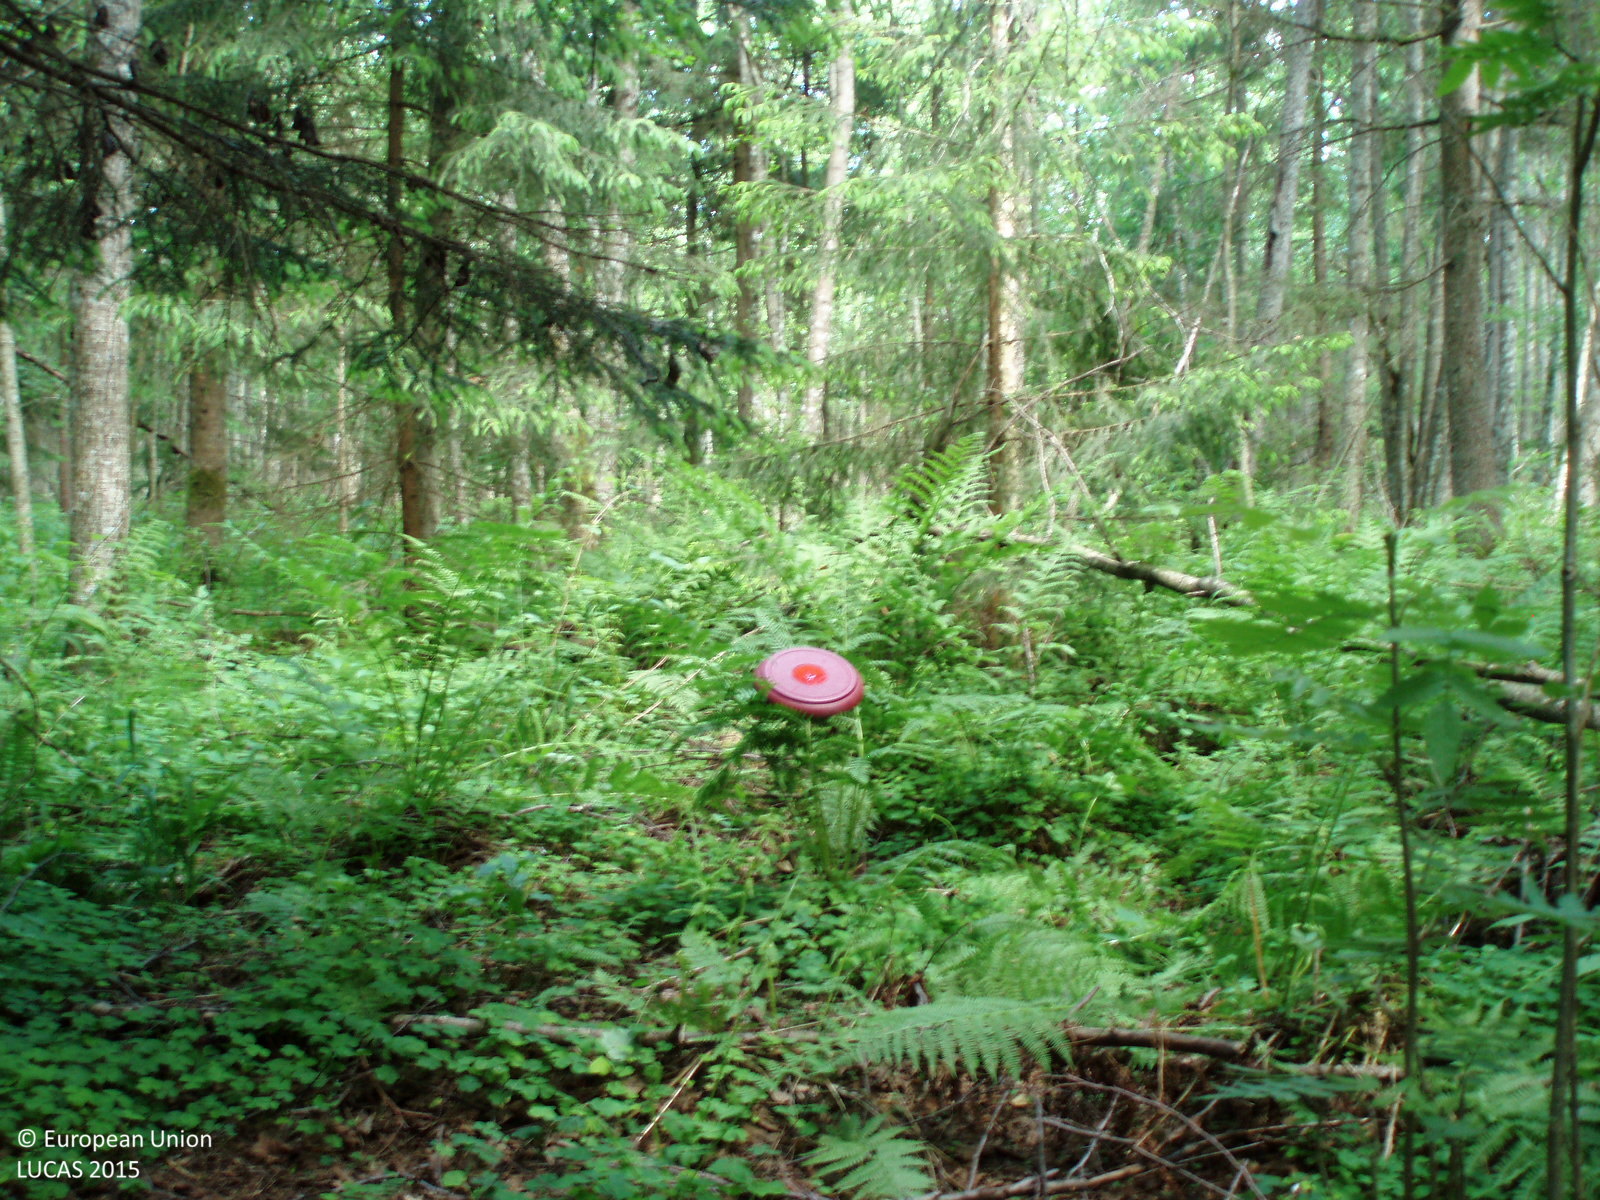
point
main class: Woodland
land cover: Spruce dominated mixed woodland
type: hemiboreal forest and nemoral coniferous forest and mixed broadleaved-coniferous forest
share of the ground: > 75 %
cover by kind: coniferous forest trees 50 %, broadleaved forest trees 40 %, herbaceous plants 10 %
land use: Forestry
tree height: > 5 m
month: June
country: LT
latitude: 55.1923
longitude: 22.4870
